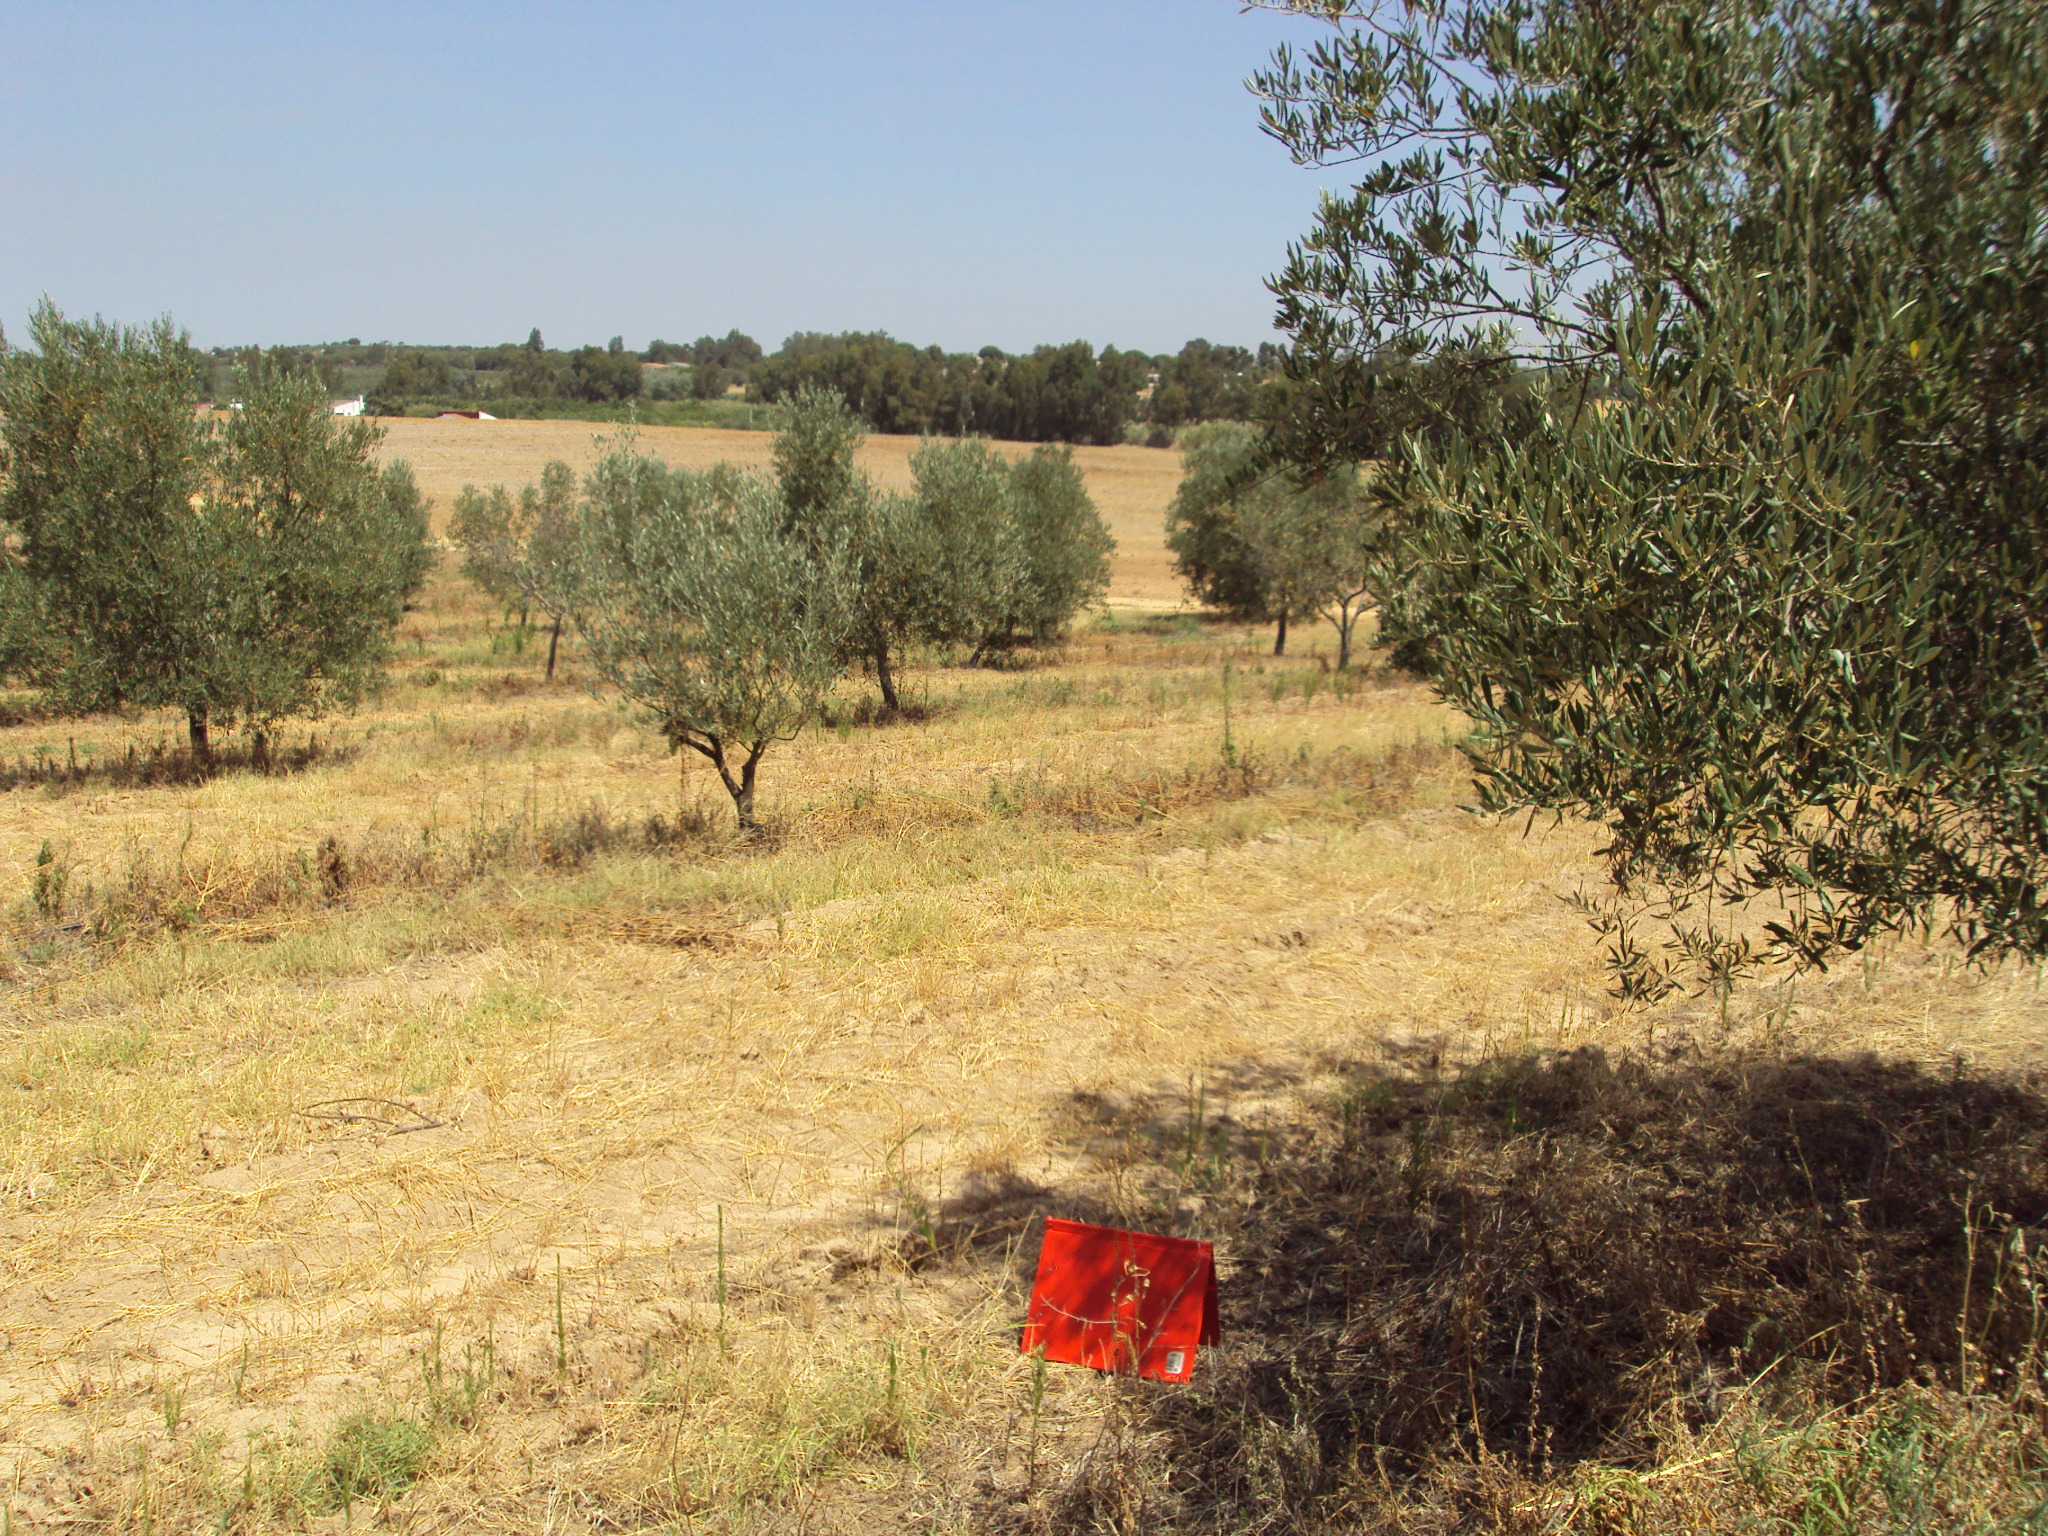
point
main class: Cropland
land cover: Olive groves
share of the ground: 50 - 75 %
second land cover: Spontaneously vegetated surfaces
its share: > 75 %
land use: Agriculture (excluding fallow land and kitchen gardens)
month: July
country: ES
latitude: 37.3447
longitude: -7.0303
